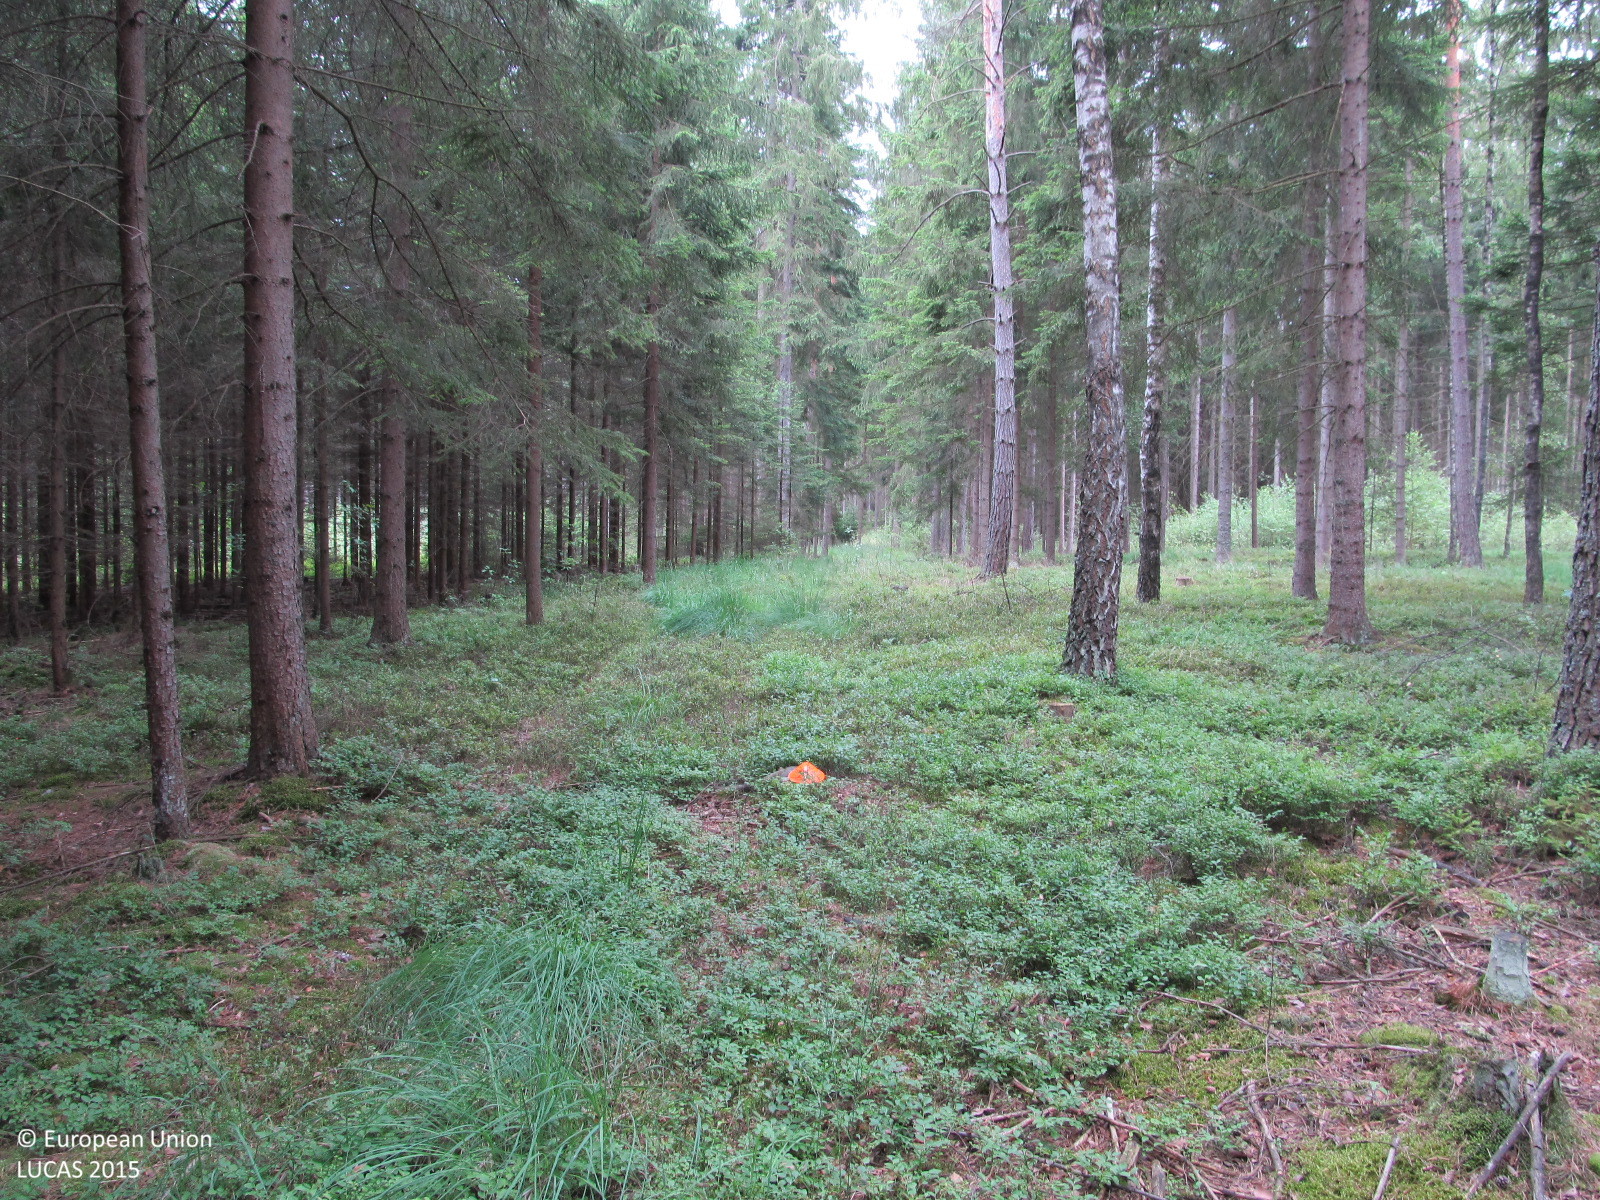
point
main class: Woodland
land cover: Spruce dominated coniferous woodland
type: hemiboreal forest and nemoral coniferous forest and mixed broadleaved-coniferous forest
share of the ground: > 75 %
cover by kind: coniferous forest trees 85 %, shrubs 5 %, herbaceous plants 5 %, lichens and mosses 5 %
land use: Forestry
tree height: > 5 m
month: July
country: AT
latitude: 48.7581
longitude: 15.0214
